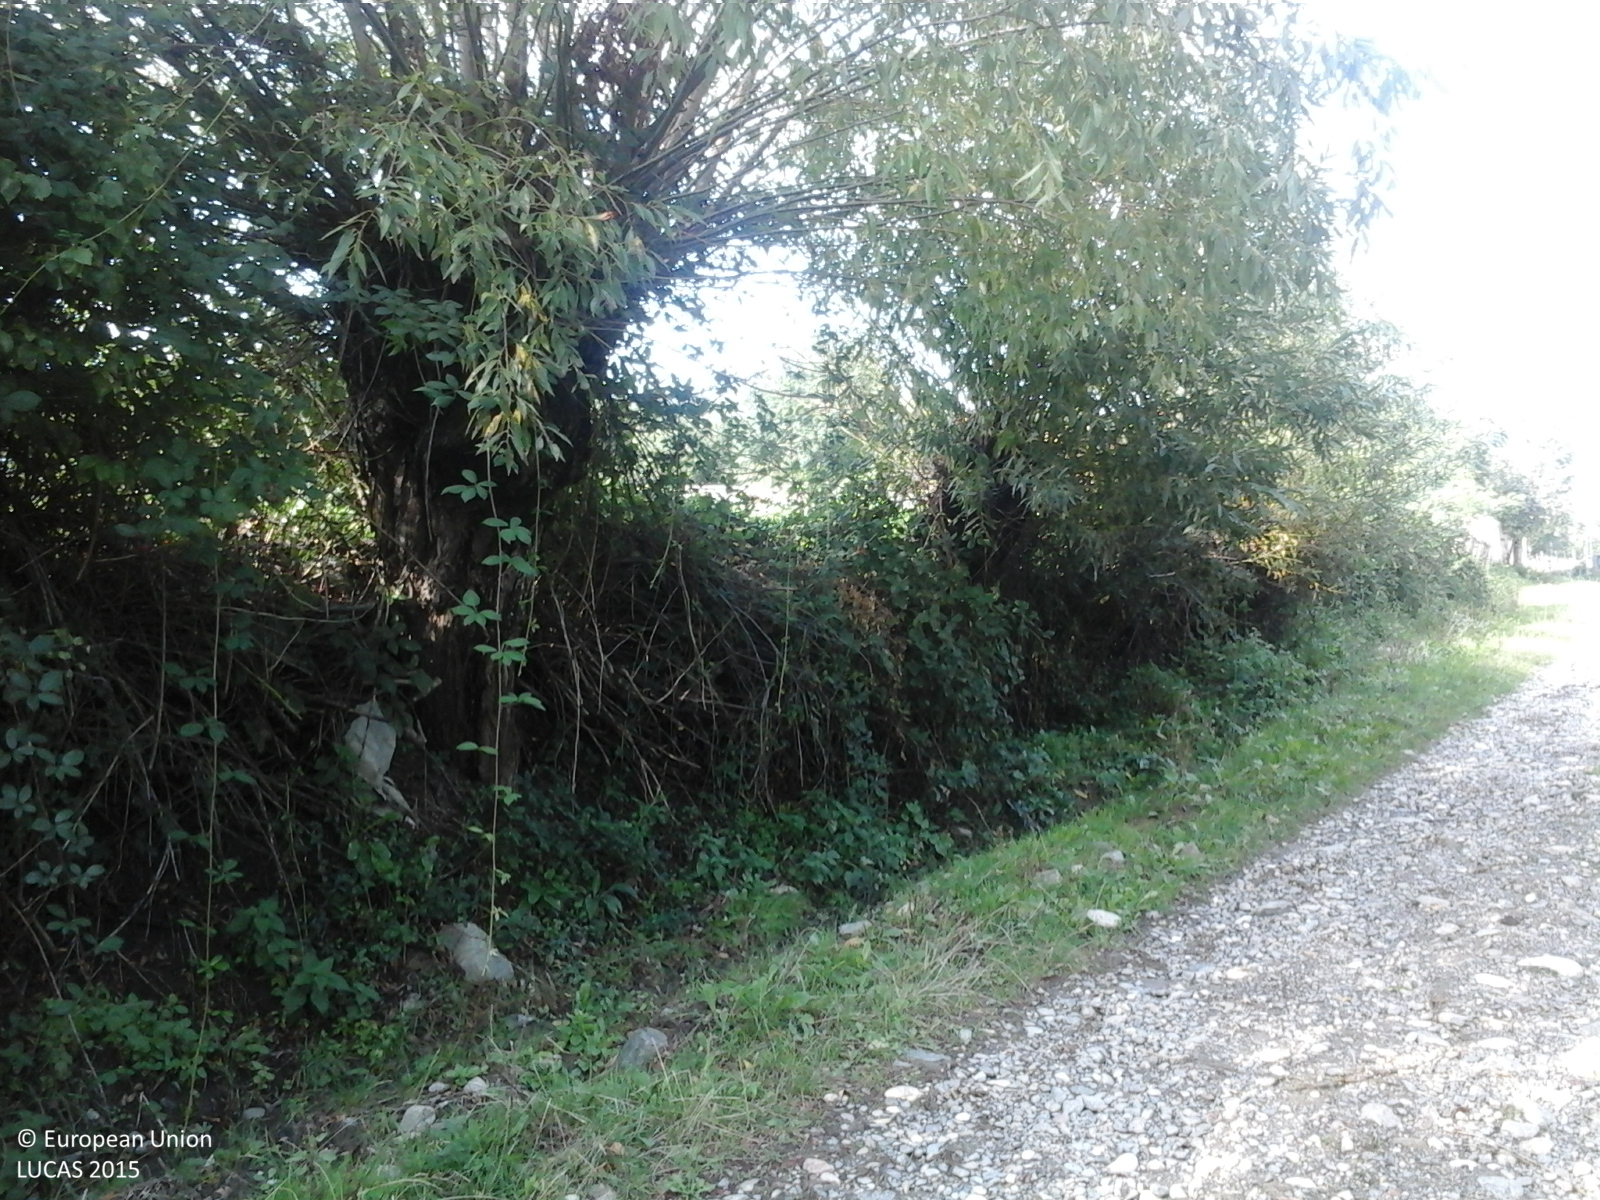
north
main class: Cropland
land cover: Other fruit trees and berries
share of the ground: 50 - 75 %
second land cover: Grassland without tree/shrub cover
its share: > 75 %
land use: Agriculture (excluding fallow land and kitchen gardens)
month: September
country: RO
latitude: 45.2910
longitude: 24.4466
